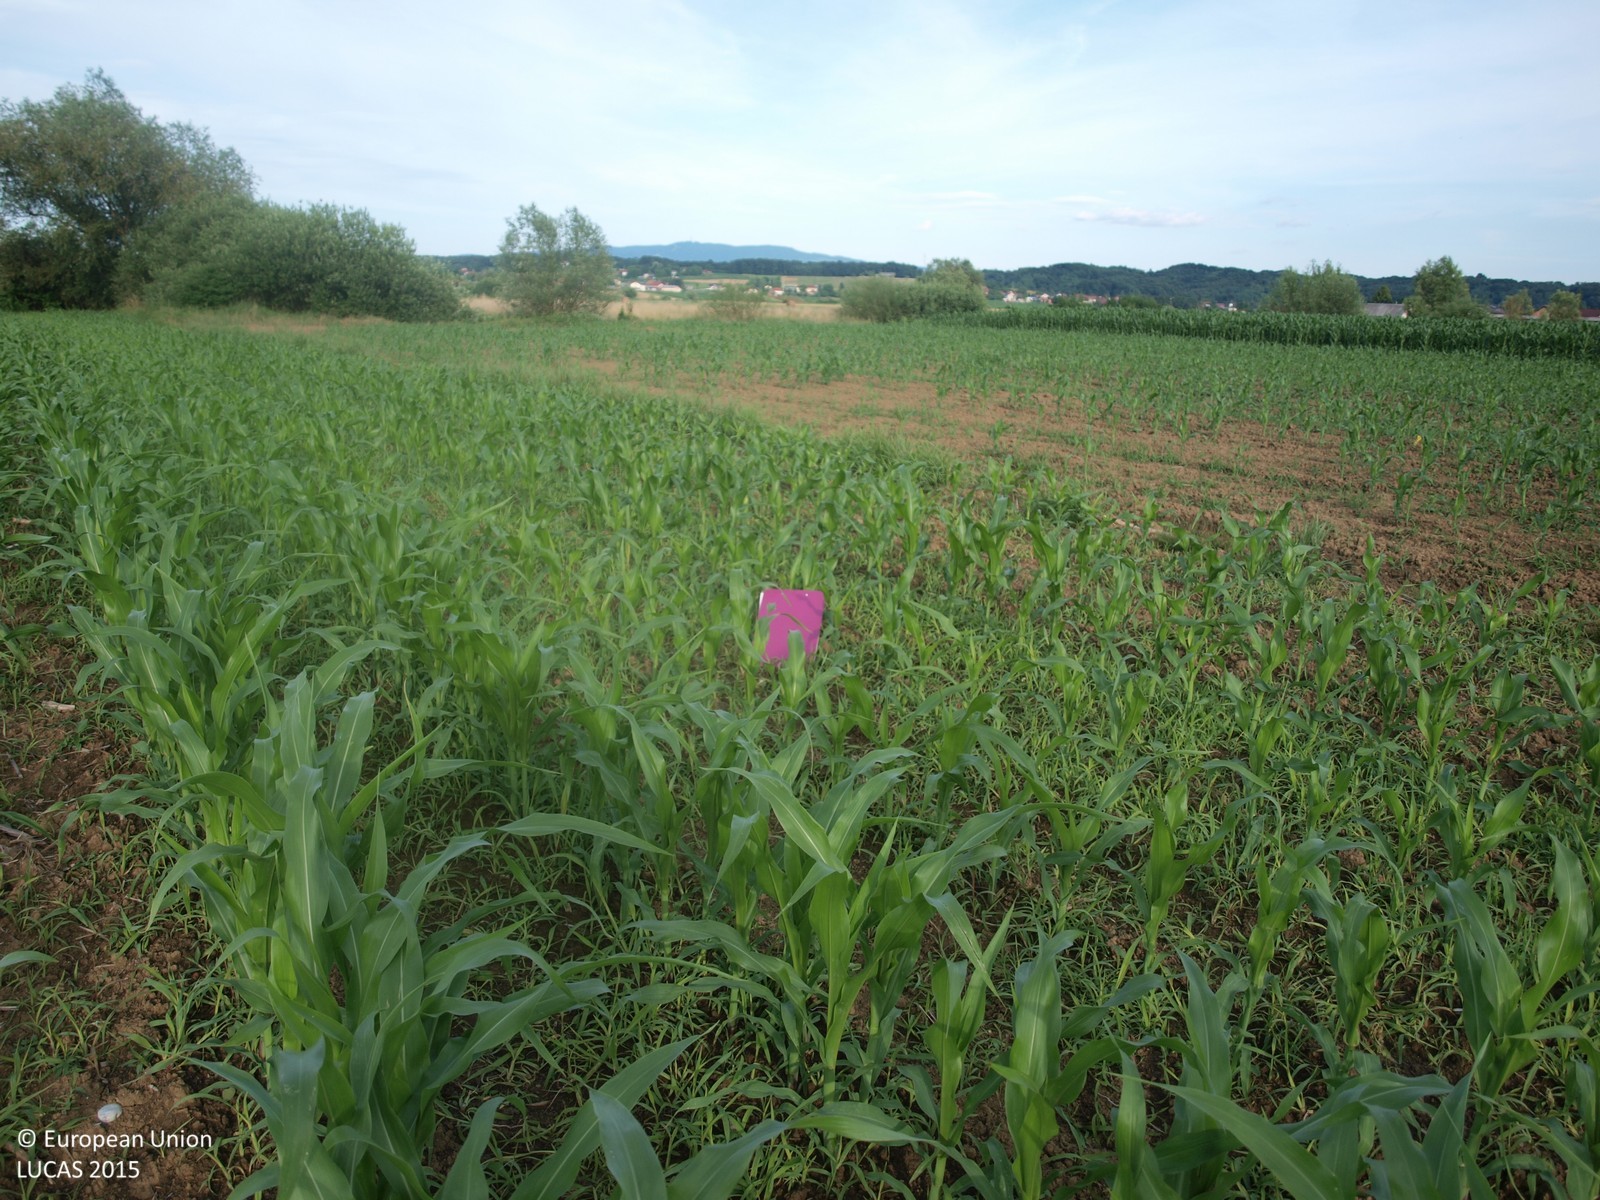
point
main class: Cropland
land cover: Maize
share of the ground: > 75 %
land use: Agriculture (excluding fallow land and kitchen gardens)
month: June
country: HR
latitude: 45.9637
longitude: 15.7142
